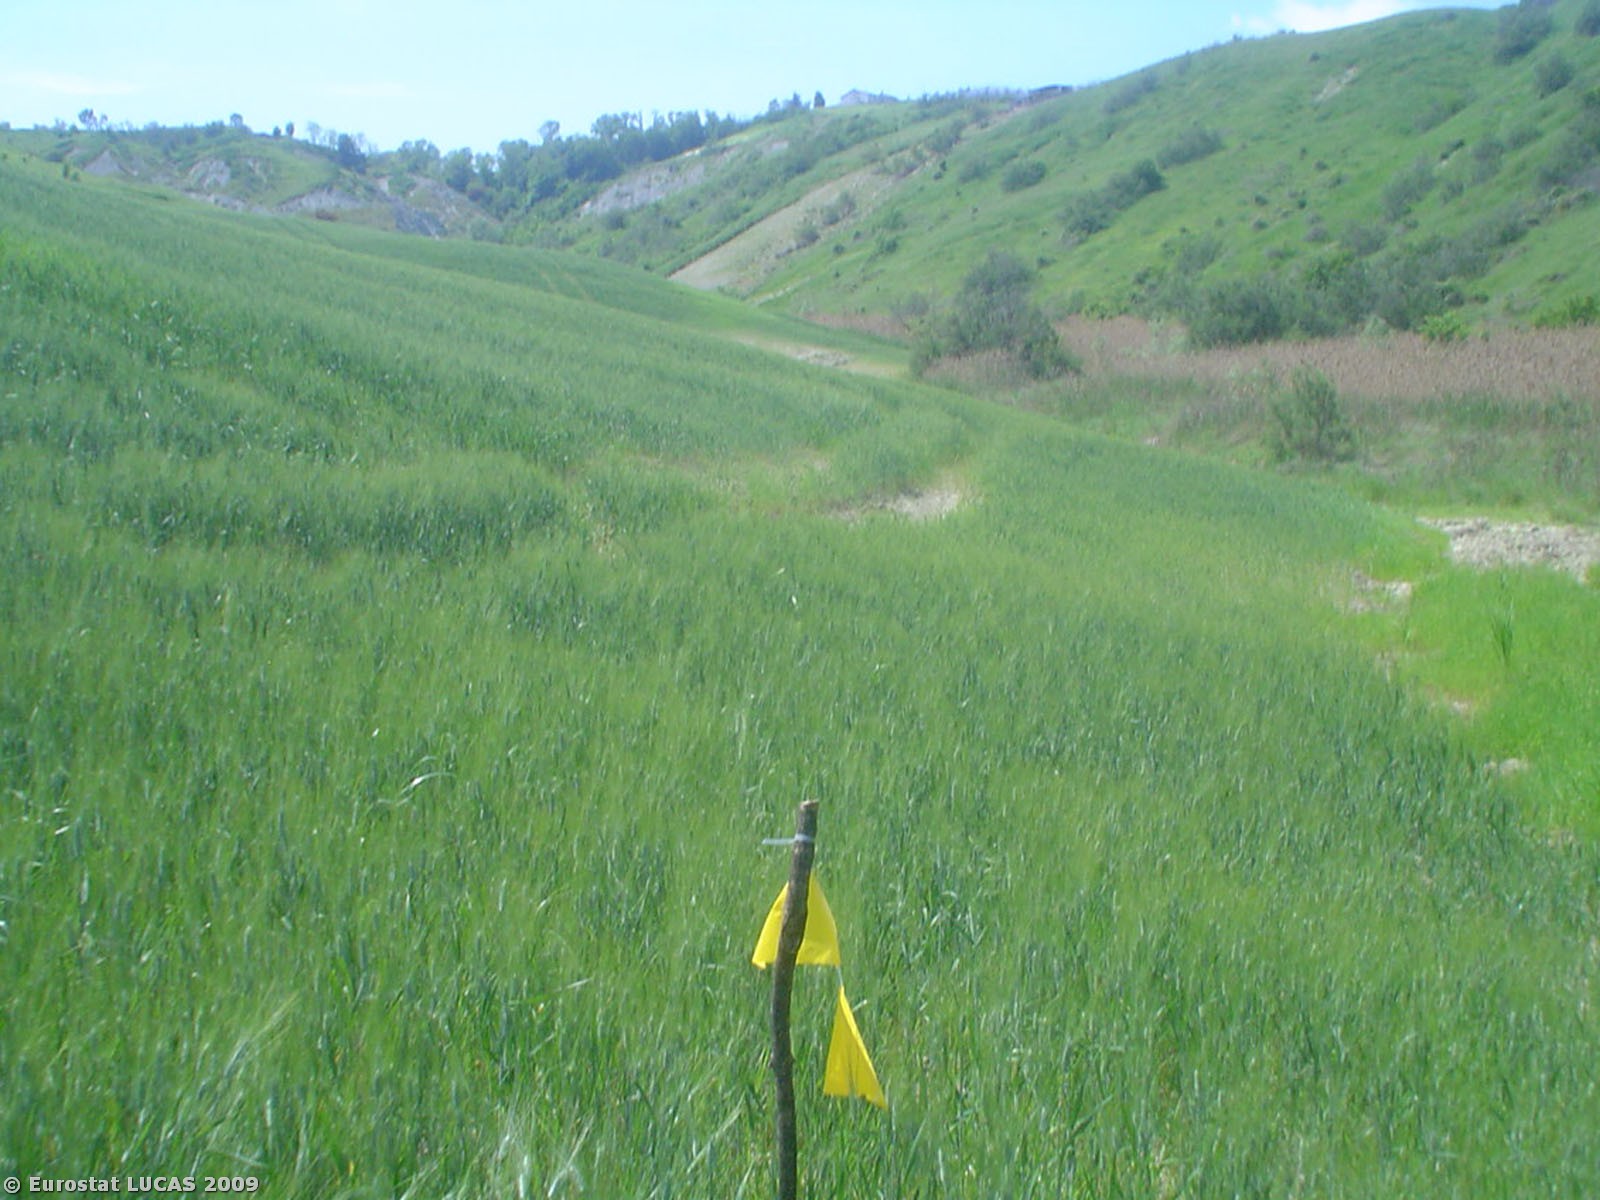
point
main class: Cropland
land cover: Durum wheat
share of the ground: > 75 %
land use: Agriculture (excluding fallow land and kitchen gardens)
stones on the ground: < 10 %
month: May
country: IT
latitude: 42.8387
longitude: 13.7212
